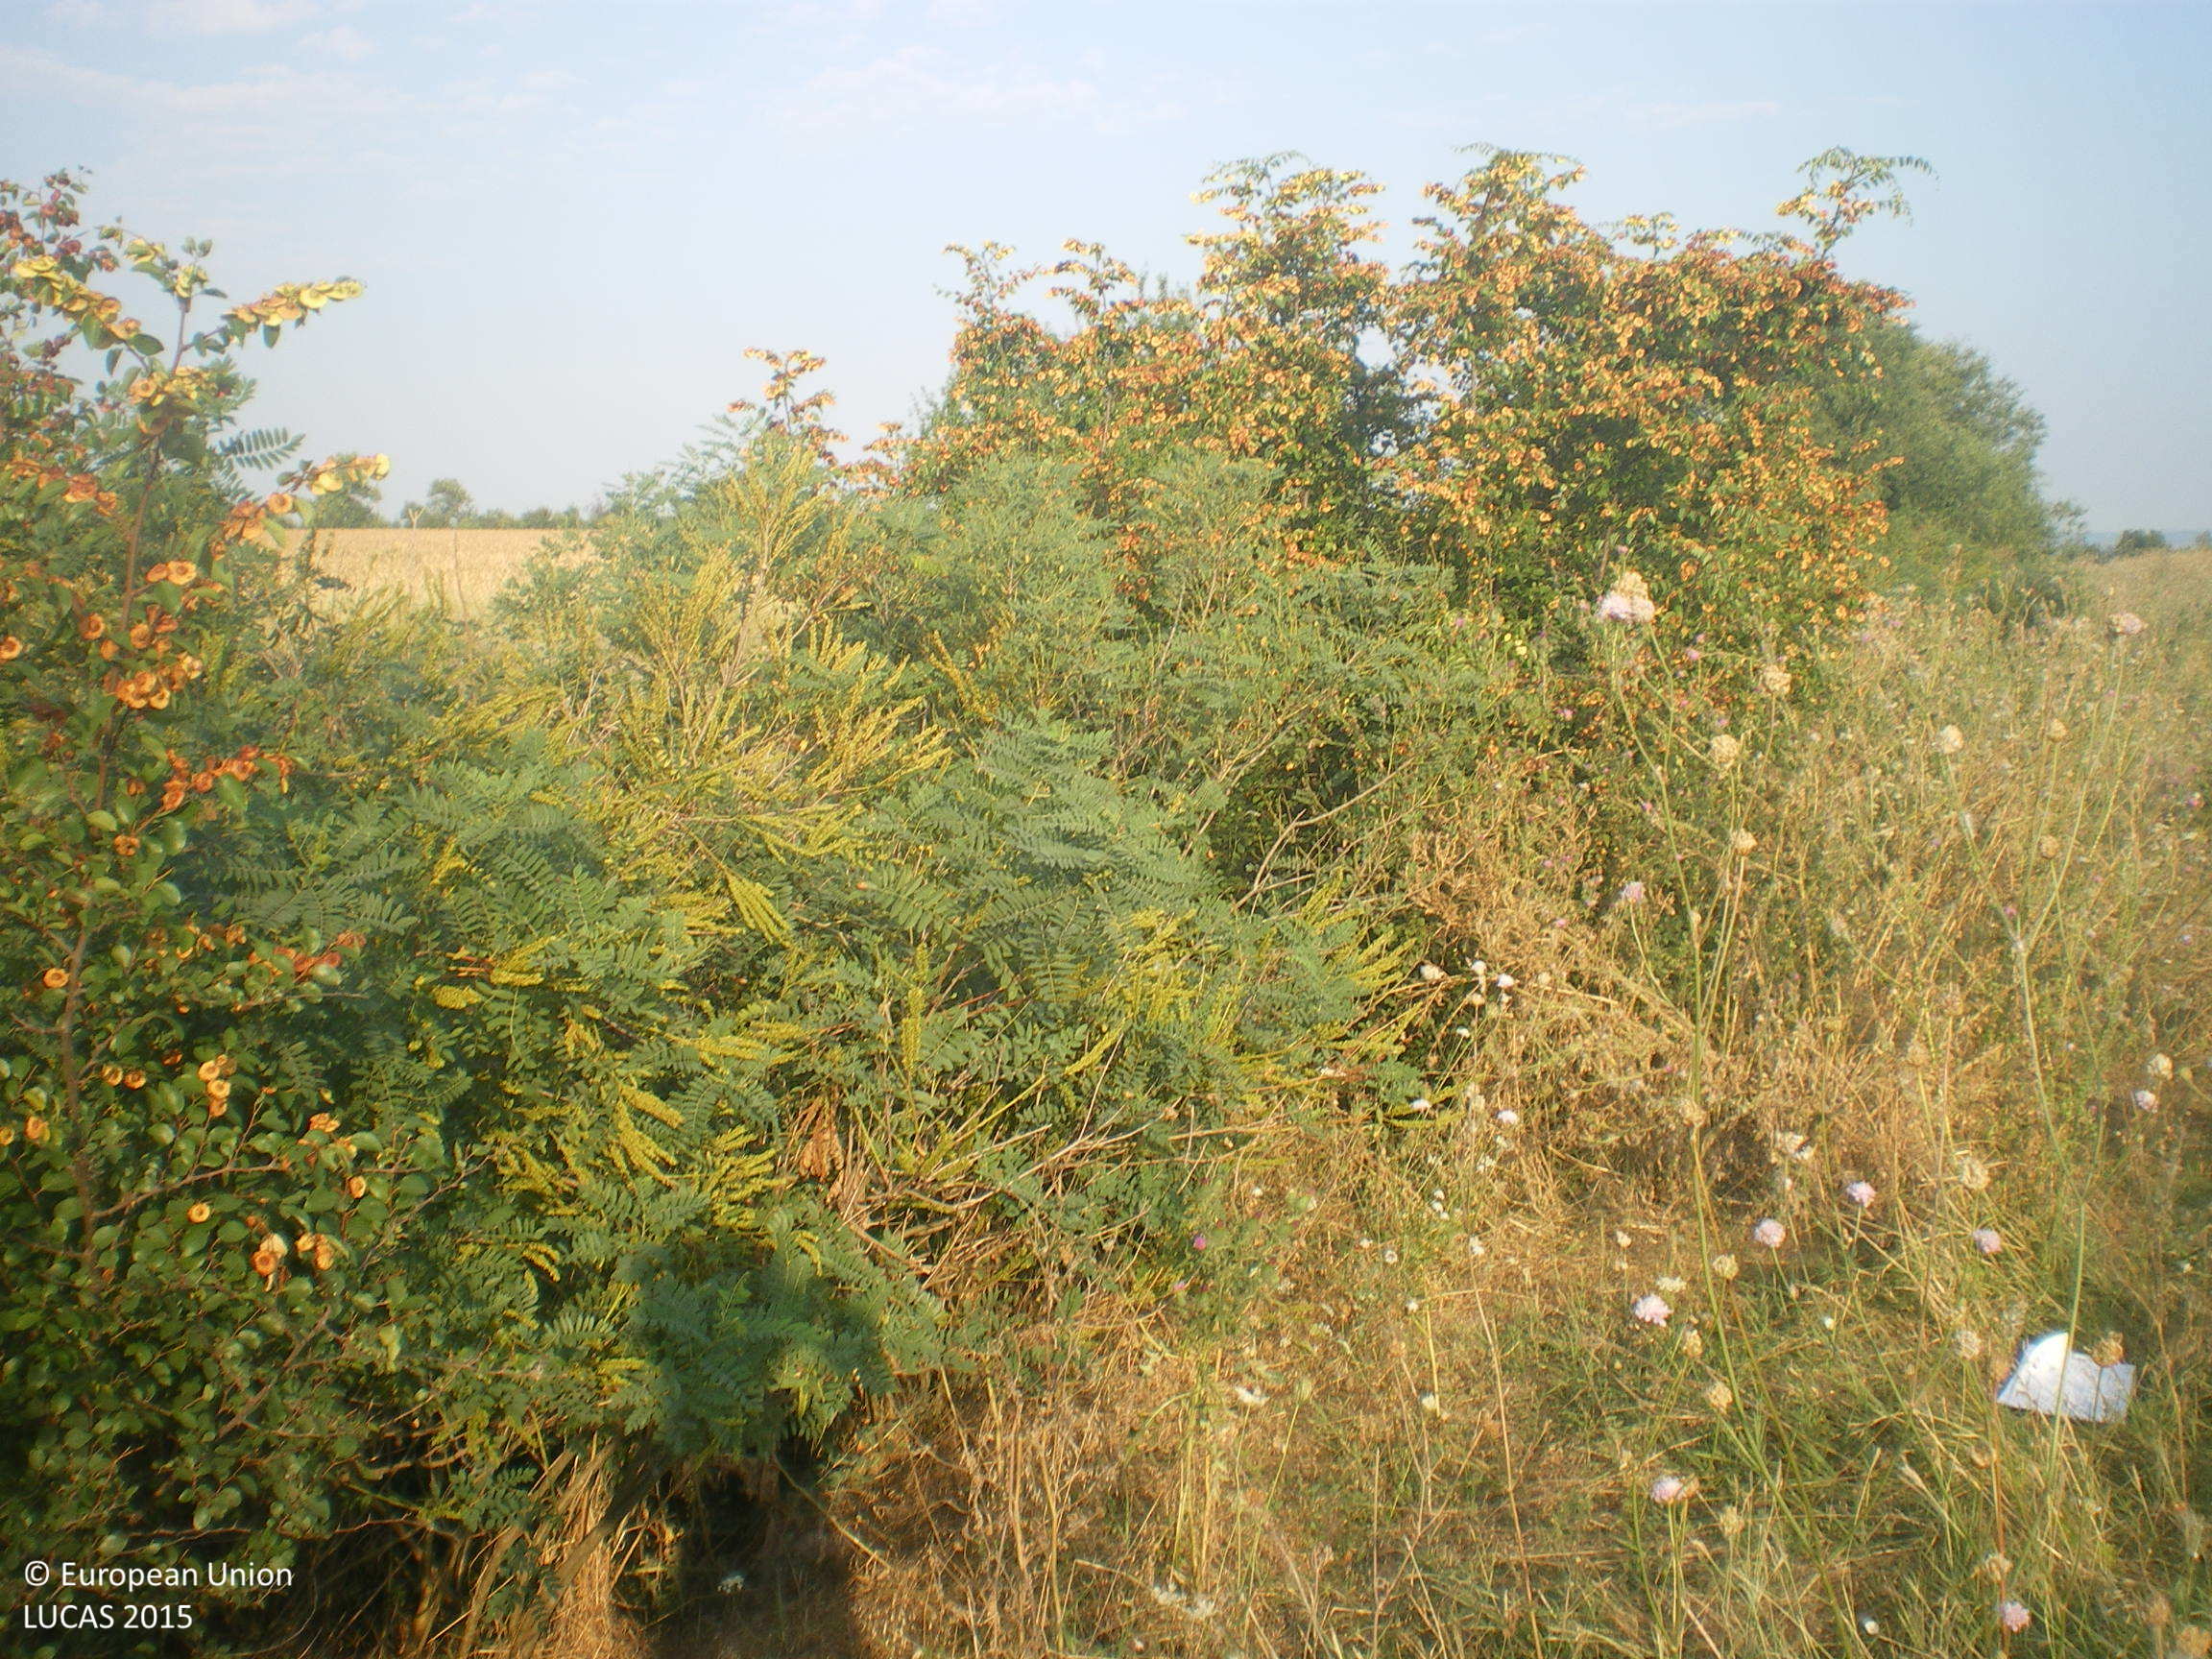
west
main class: Shrubland
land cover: Shrubland without tree cover
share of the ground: > 75 %
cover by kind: shrubs 75 %, herbaceous plants 25 %
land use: Agriculture (excluding fallow land and kitchen gardens)
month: August
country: BG
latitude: 42.3010
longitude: 25.7078
